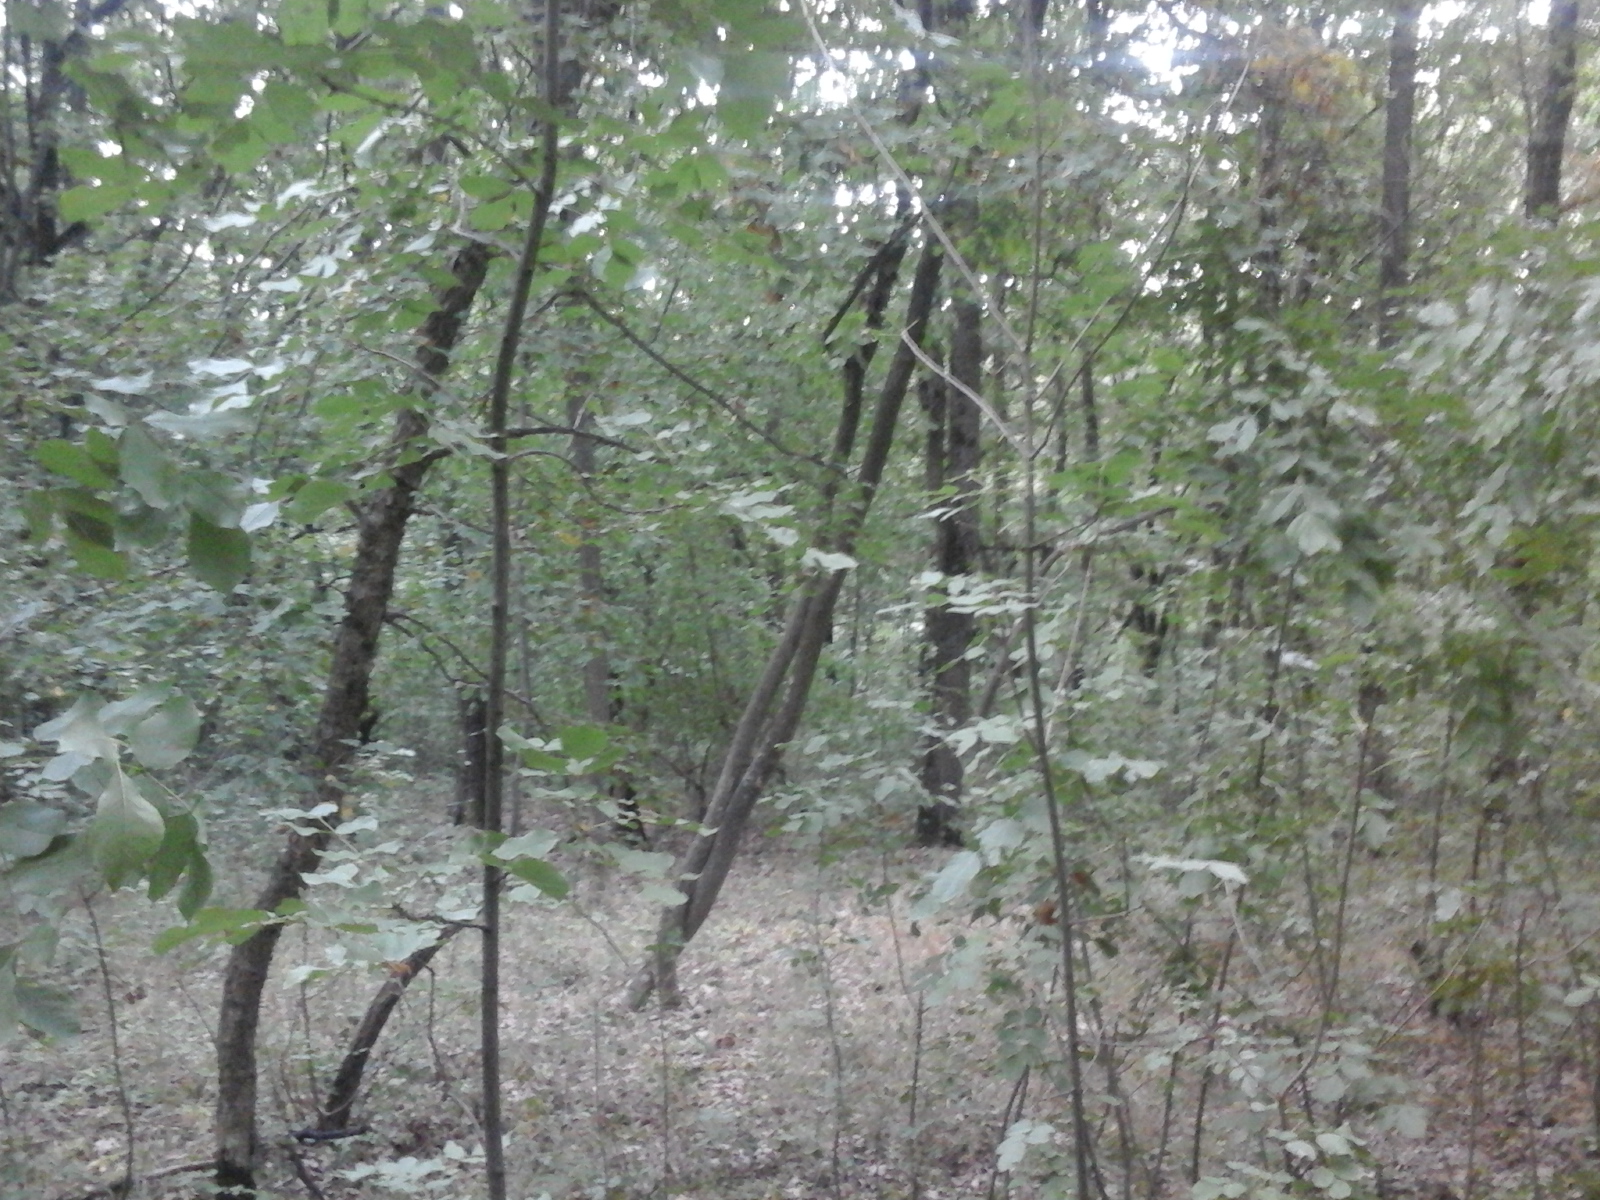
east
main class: Woodland
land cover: Broadleaved woodland
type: acidophilous oak and oak-birch forest
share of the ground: > 75 %
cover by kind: broadleaved forest trees 100 %
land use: Forestry
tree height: > 5 m
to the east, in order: Broadleaved woodland
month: August
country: RO
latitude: 44.6160
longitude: 23.3469
